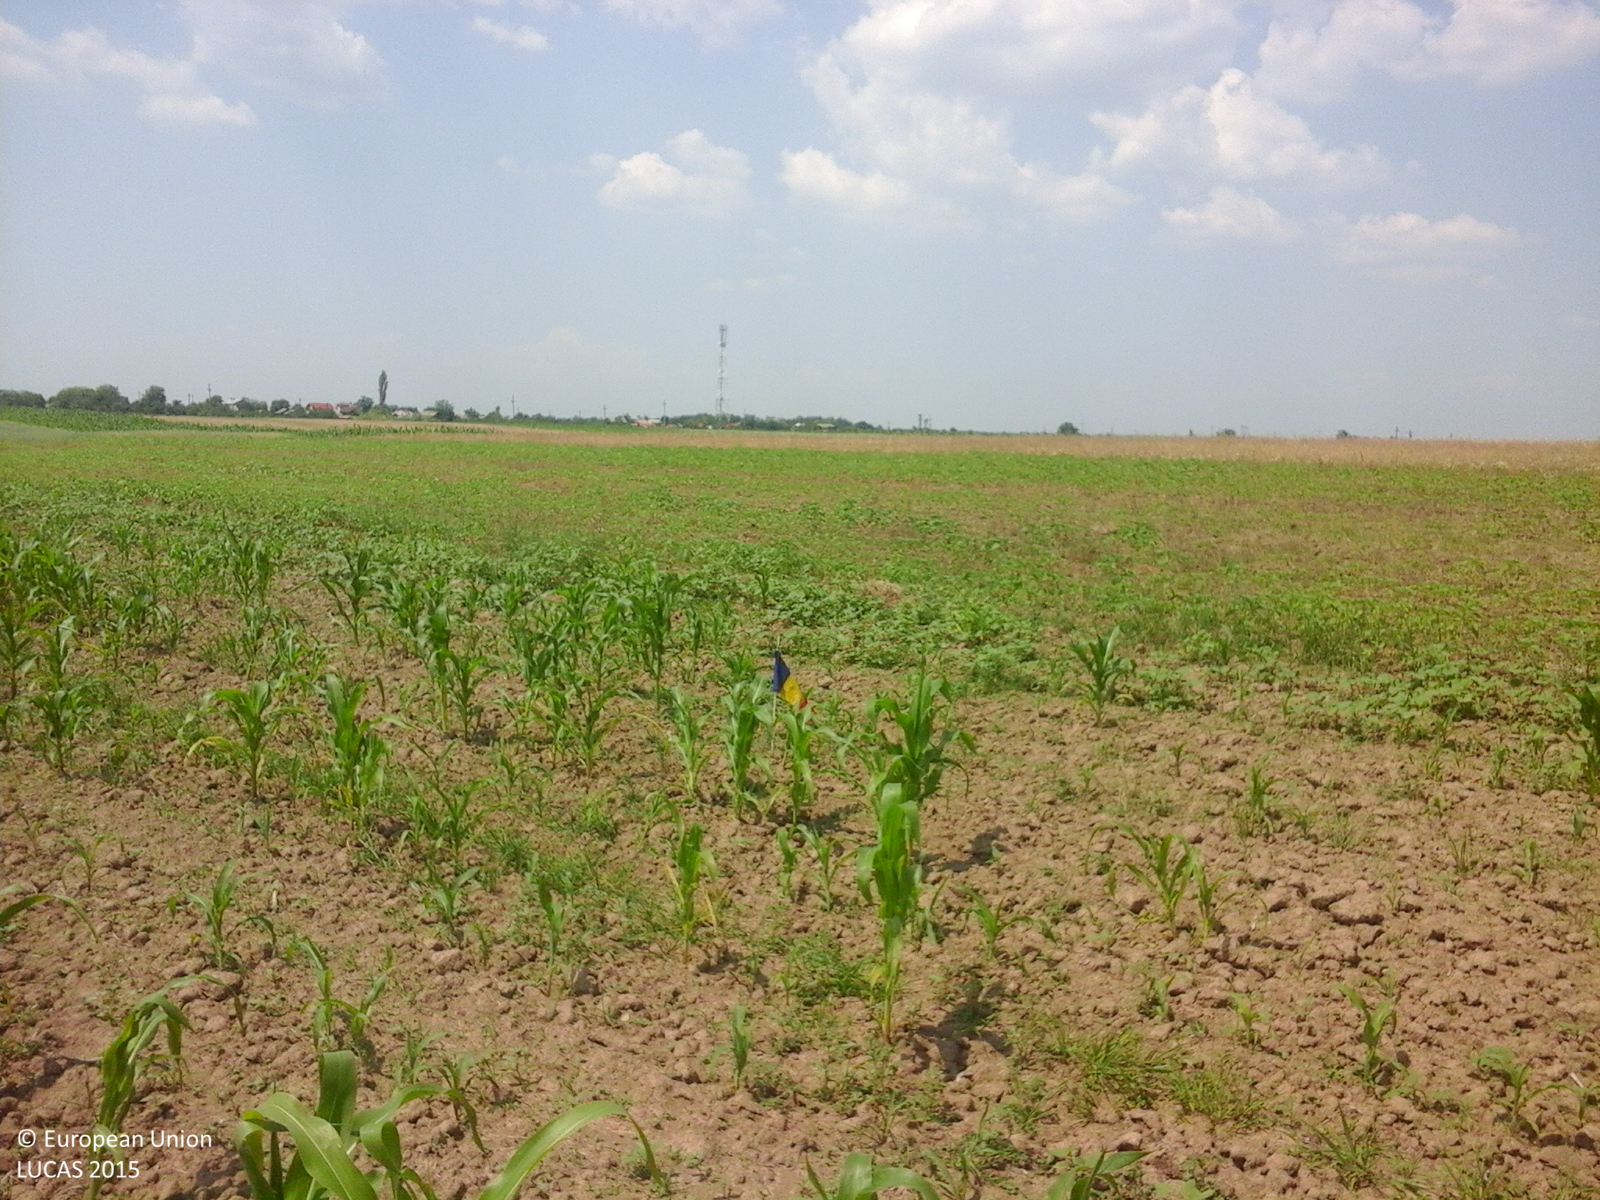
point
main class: Cropland
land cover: Maize
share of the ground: < 10 %
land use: Agriculture (excluding fallow land and kitchen gardens)
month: July
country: RO
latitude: 44.7761
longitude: 24.4661
